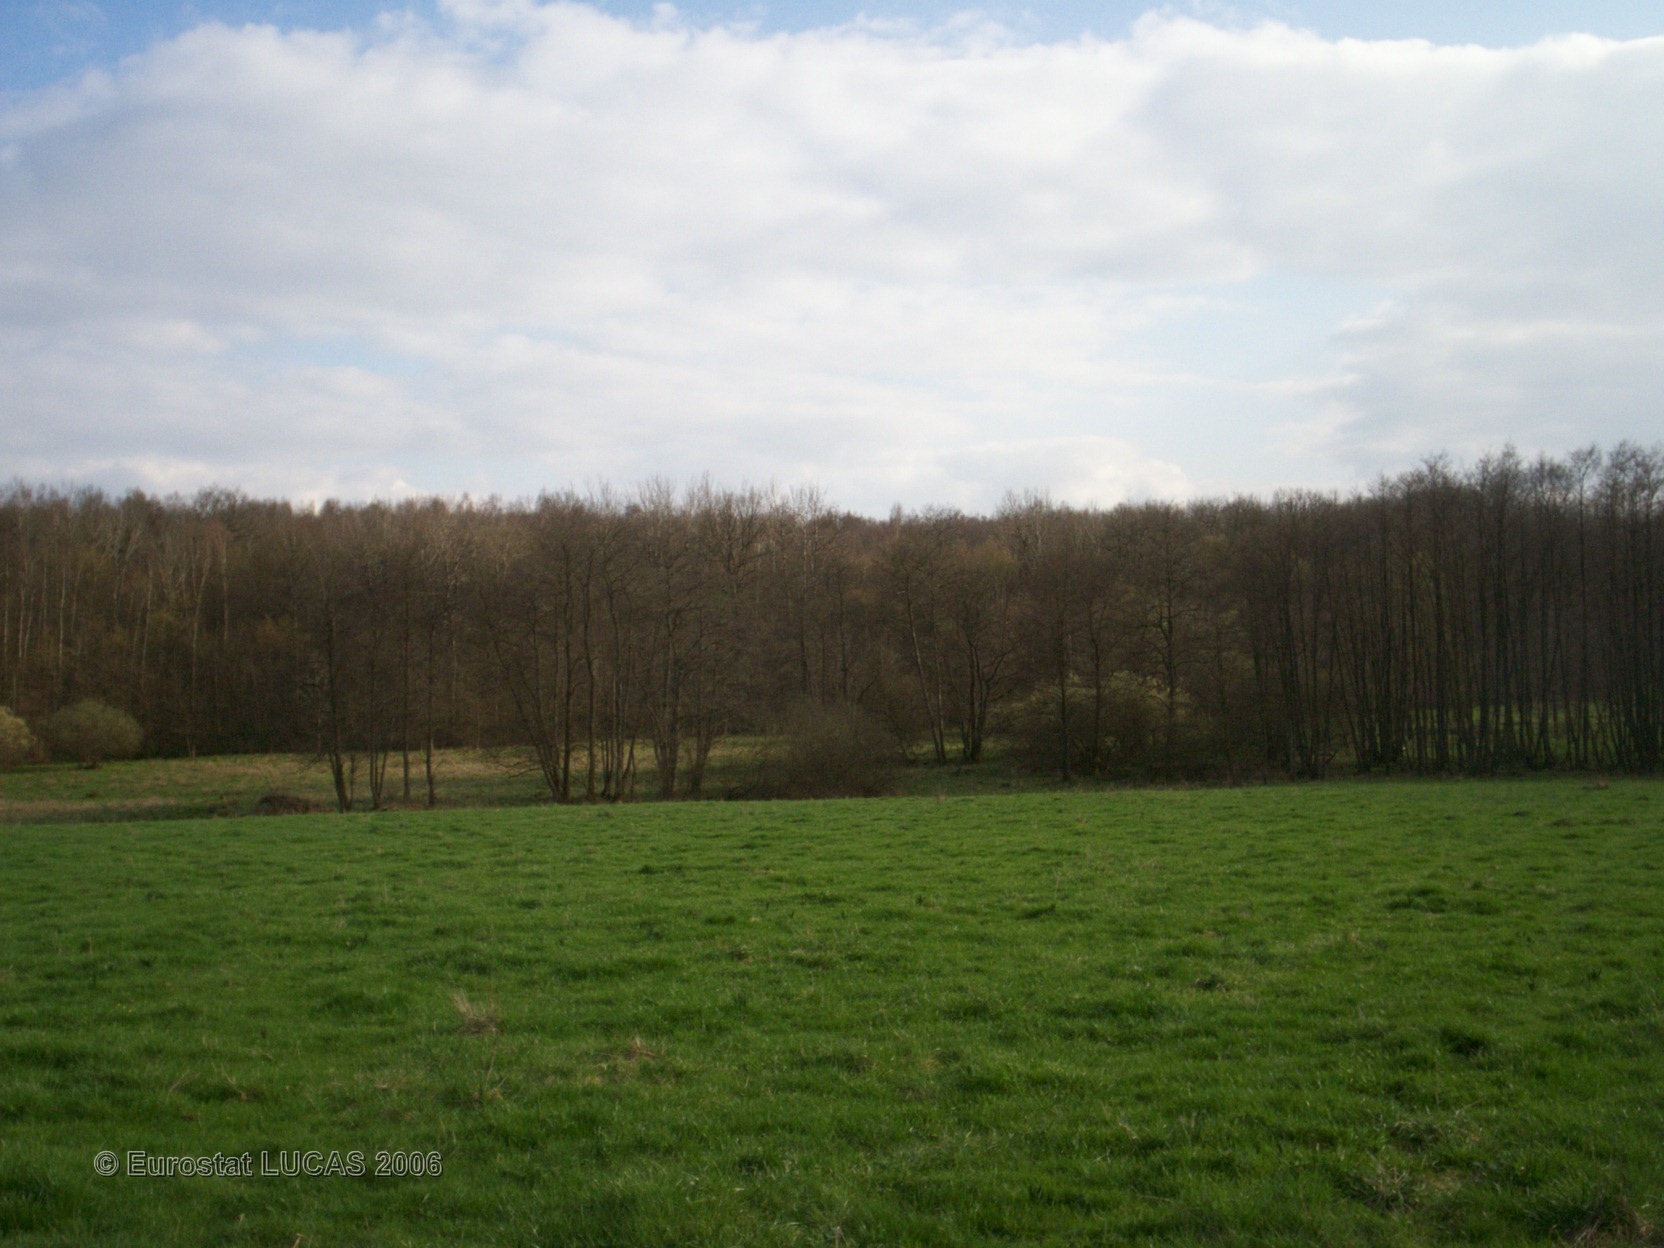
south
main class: Grassland
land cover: Grassland without tree/shrub cover
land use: Agriculture (excluding fallow land and kitchen gardens)
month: April
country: FR
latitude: 49.5177
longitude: 5.0387
